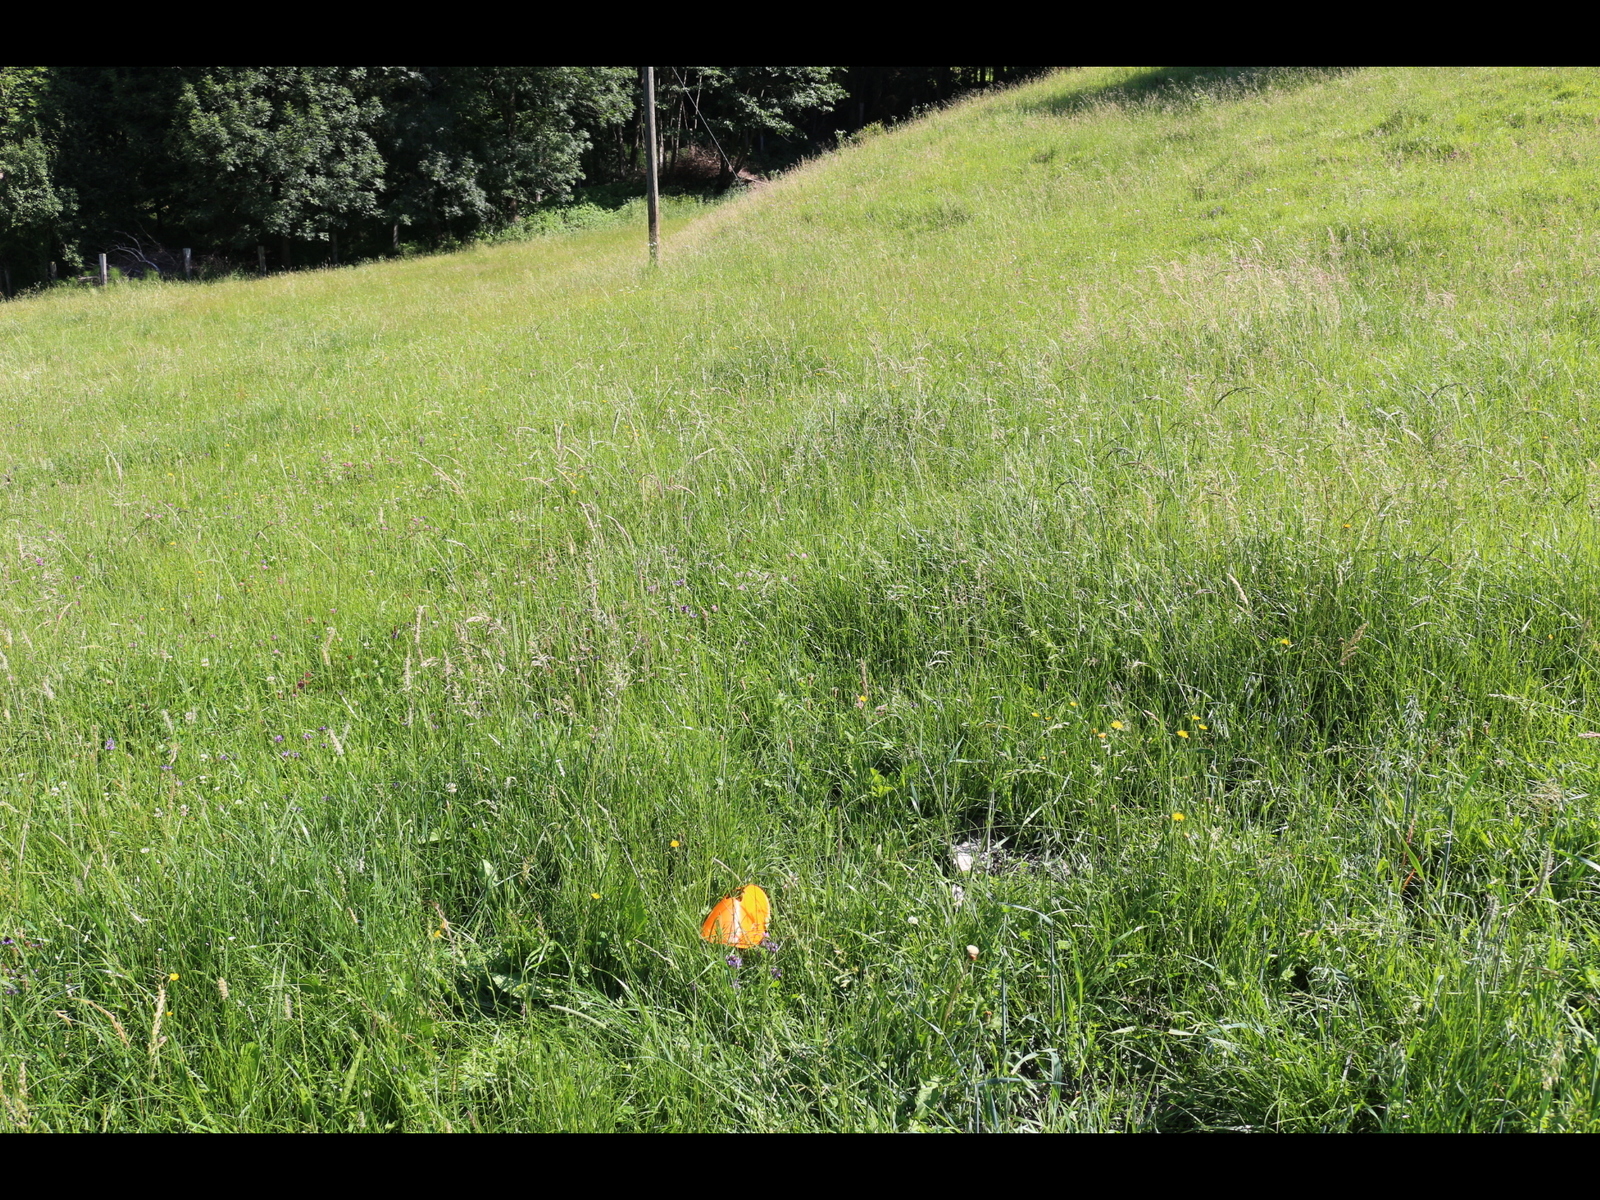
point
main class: Grassland
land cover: Grassland without tree/shrub cover
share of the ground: > 75 %
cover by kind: herbaceous plants 100 %
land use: Agriculture (excluding fallow land and kitchen gardens)
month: July
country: AT
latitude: 46.5984
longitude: 13.5608
